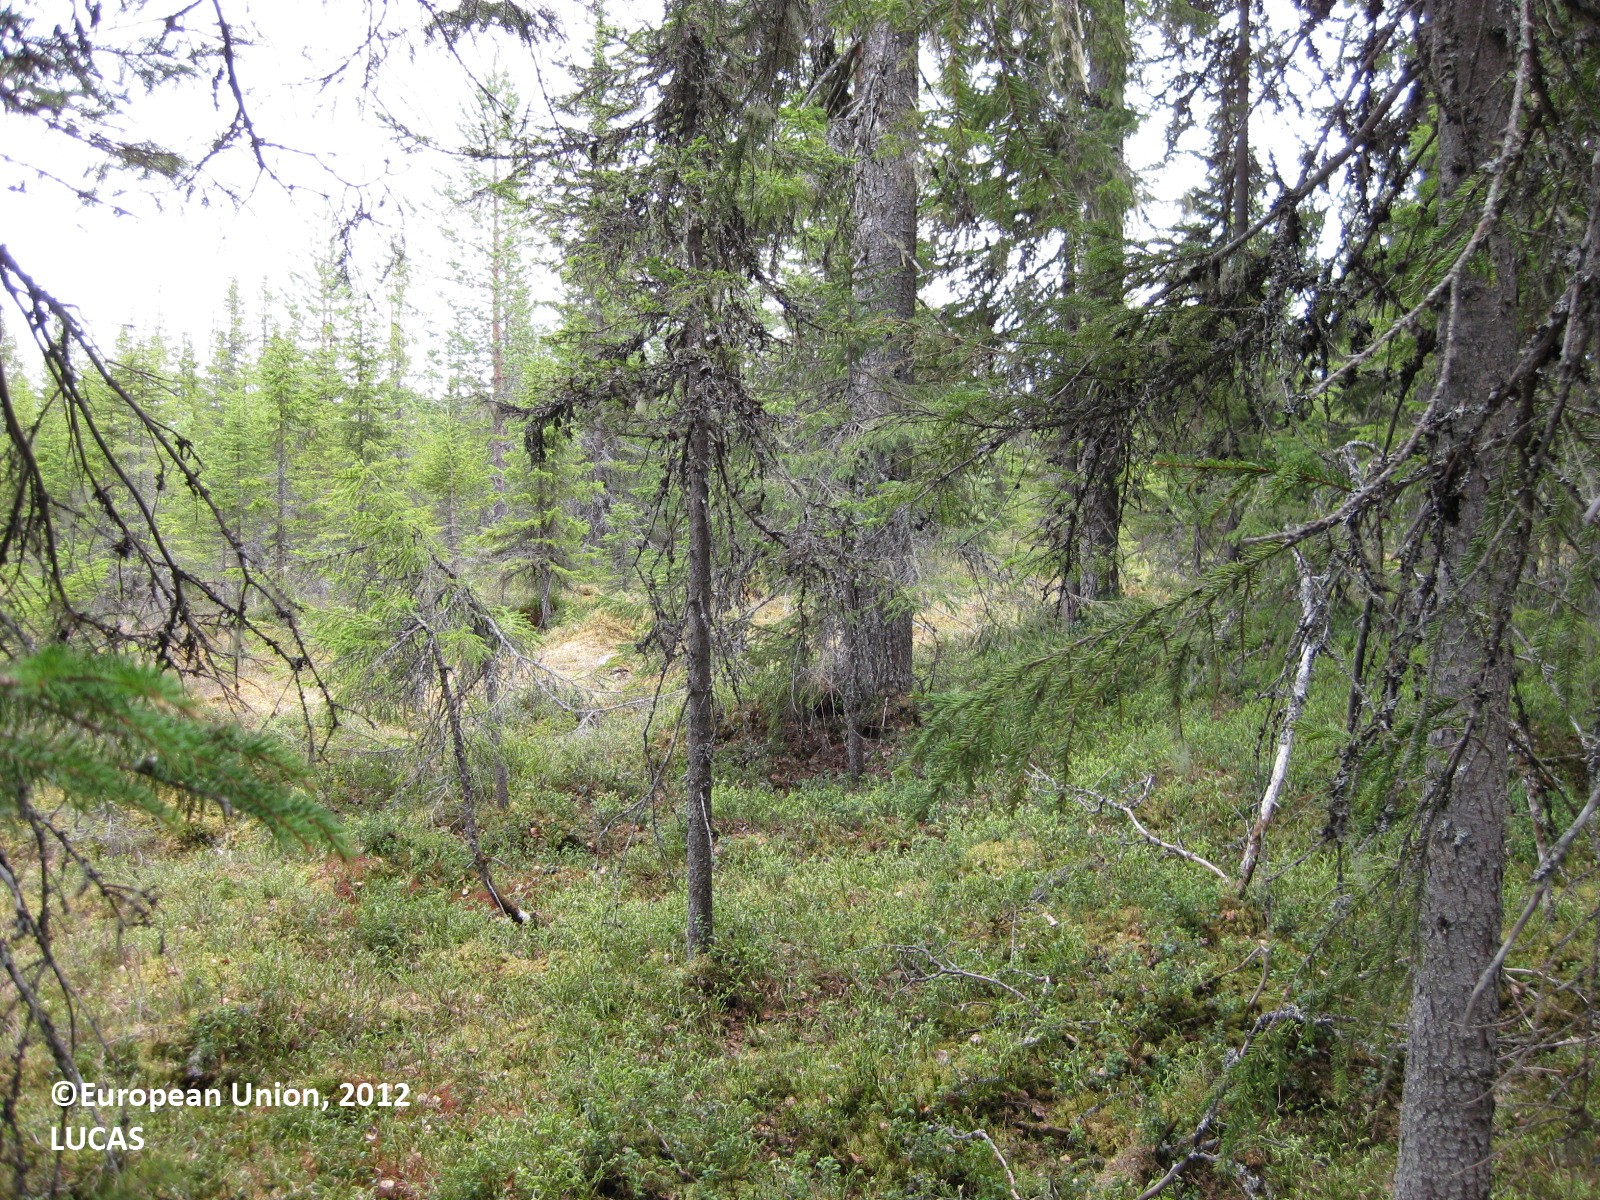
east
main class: Woodland
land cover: Spruce dominated coniferous woodland
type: boreal forest
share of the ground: > 75 %
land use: Forestry
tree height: > 5 m
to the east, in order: Spruce dominated coniferous woodland; Shrubland with sparse tree cover; Pine dominated coniferous woodland; Other mixed woodland
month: June
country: FI
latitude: 65.3253
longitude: 29.1882
